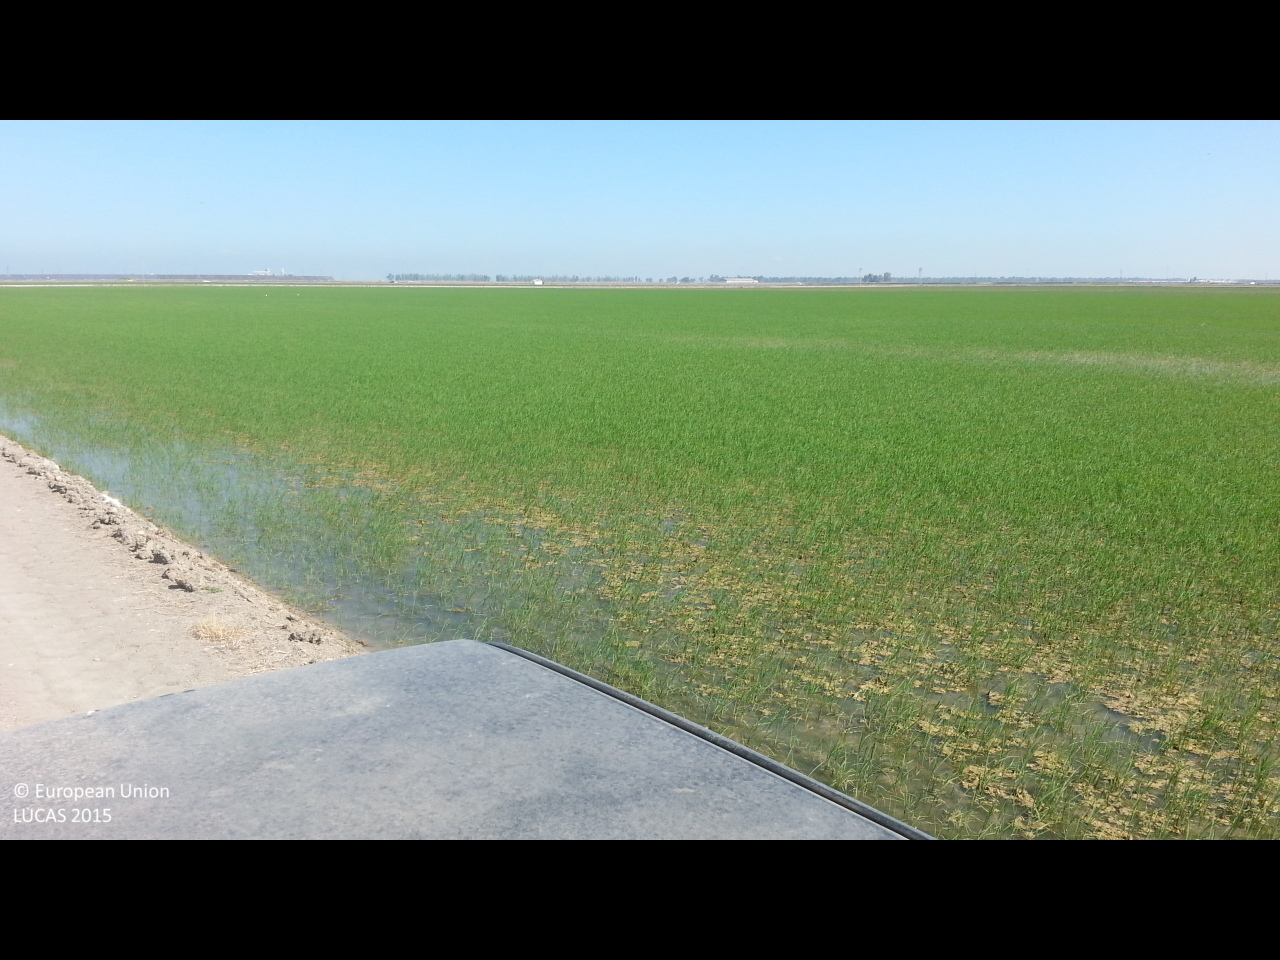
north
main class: Cropland
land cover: Rice
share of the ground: > 75 %
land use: Agriculture (excluding fallow land and kitchen gardens)
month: June
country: ES
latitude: 37.0620
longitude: -6.0211
